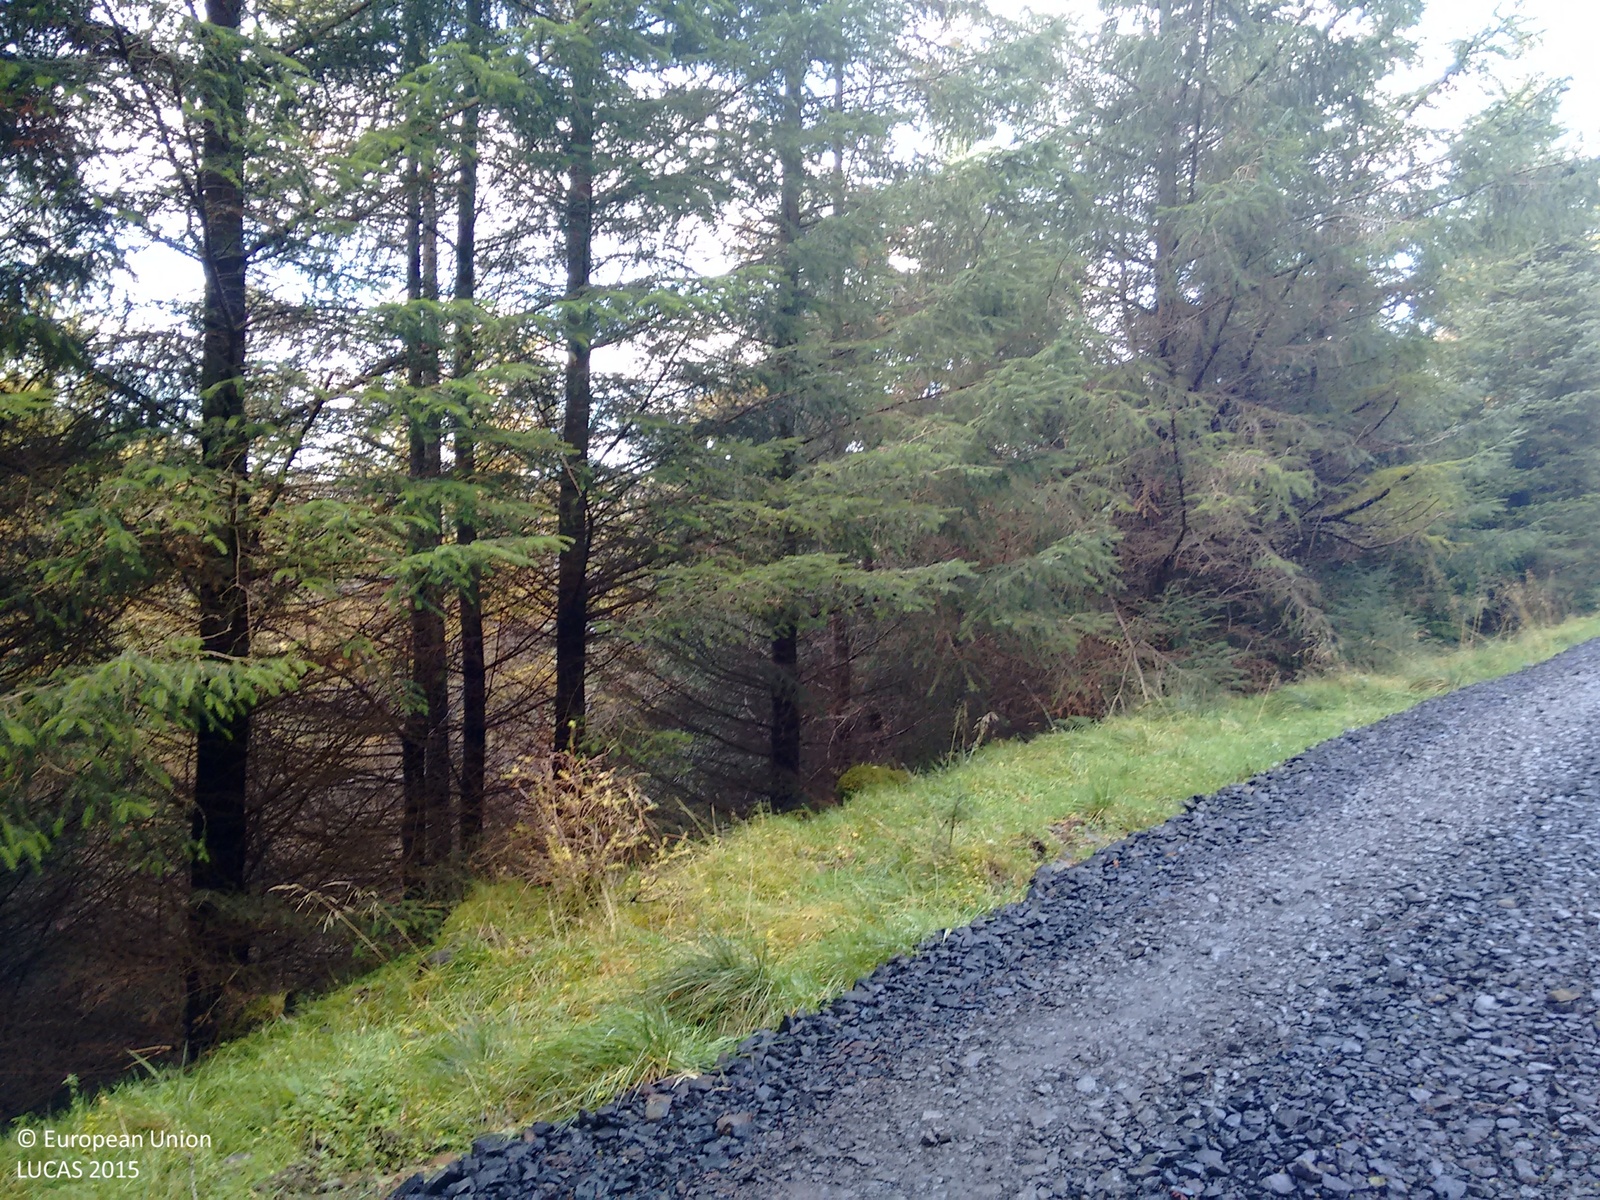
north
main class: Woodland
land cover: Spruce dominated coniferous woodland
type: exotic forest
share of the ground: > 75 %
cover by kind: coniferous forest trees 100 %
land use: Forestry
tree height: > 5 m
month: October
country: GB
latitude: 56.5808
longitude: -5.7720
